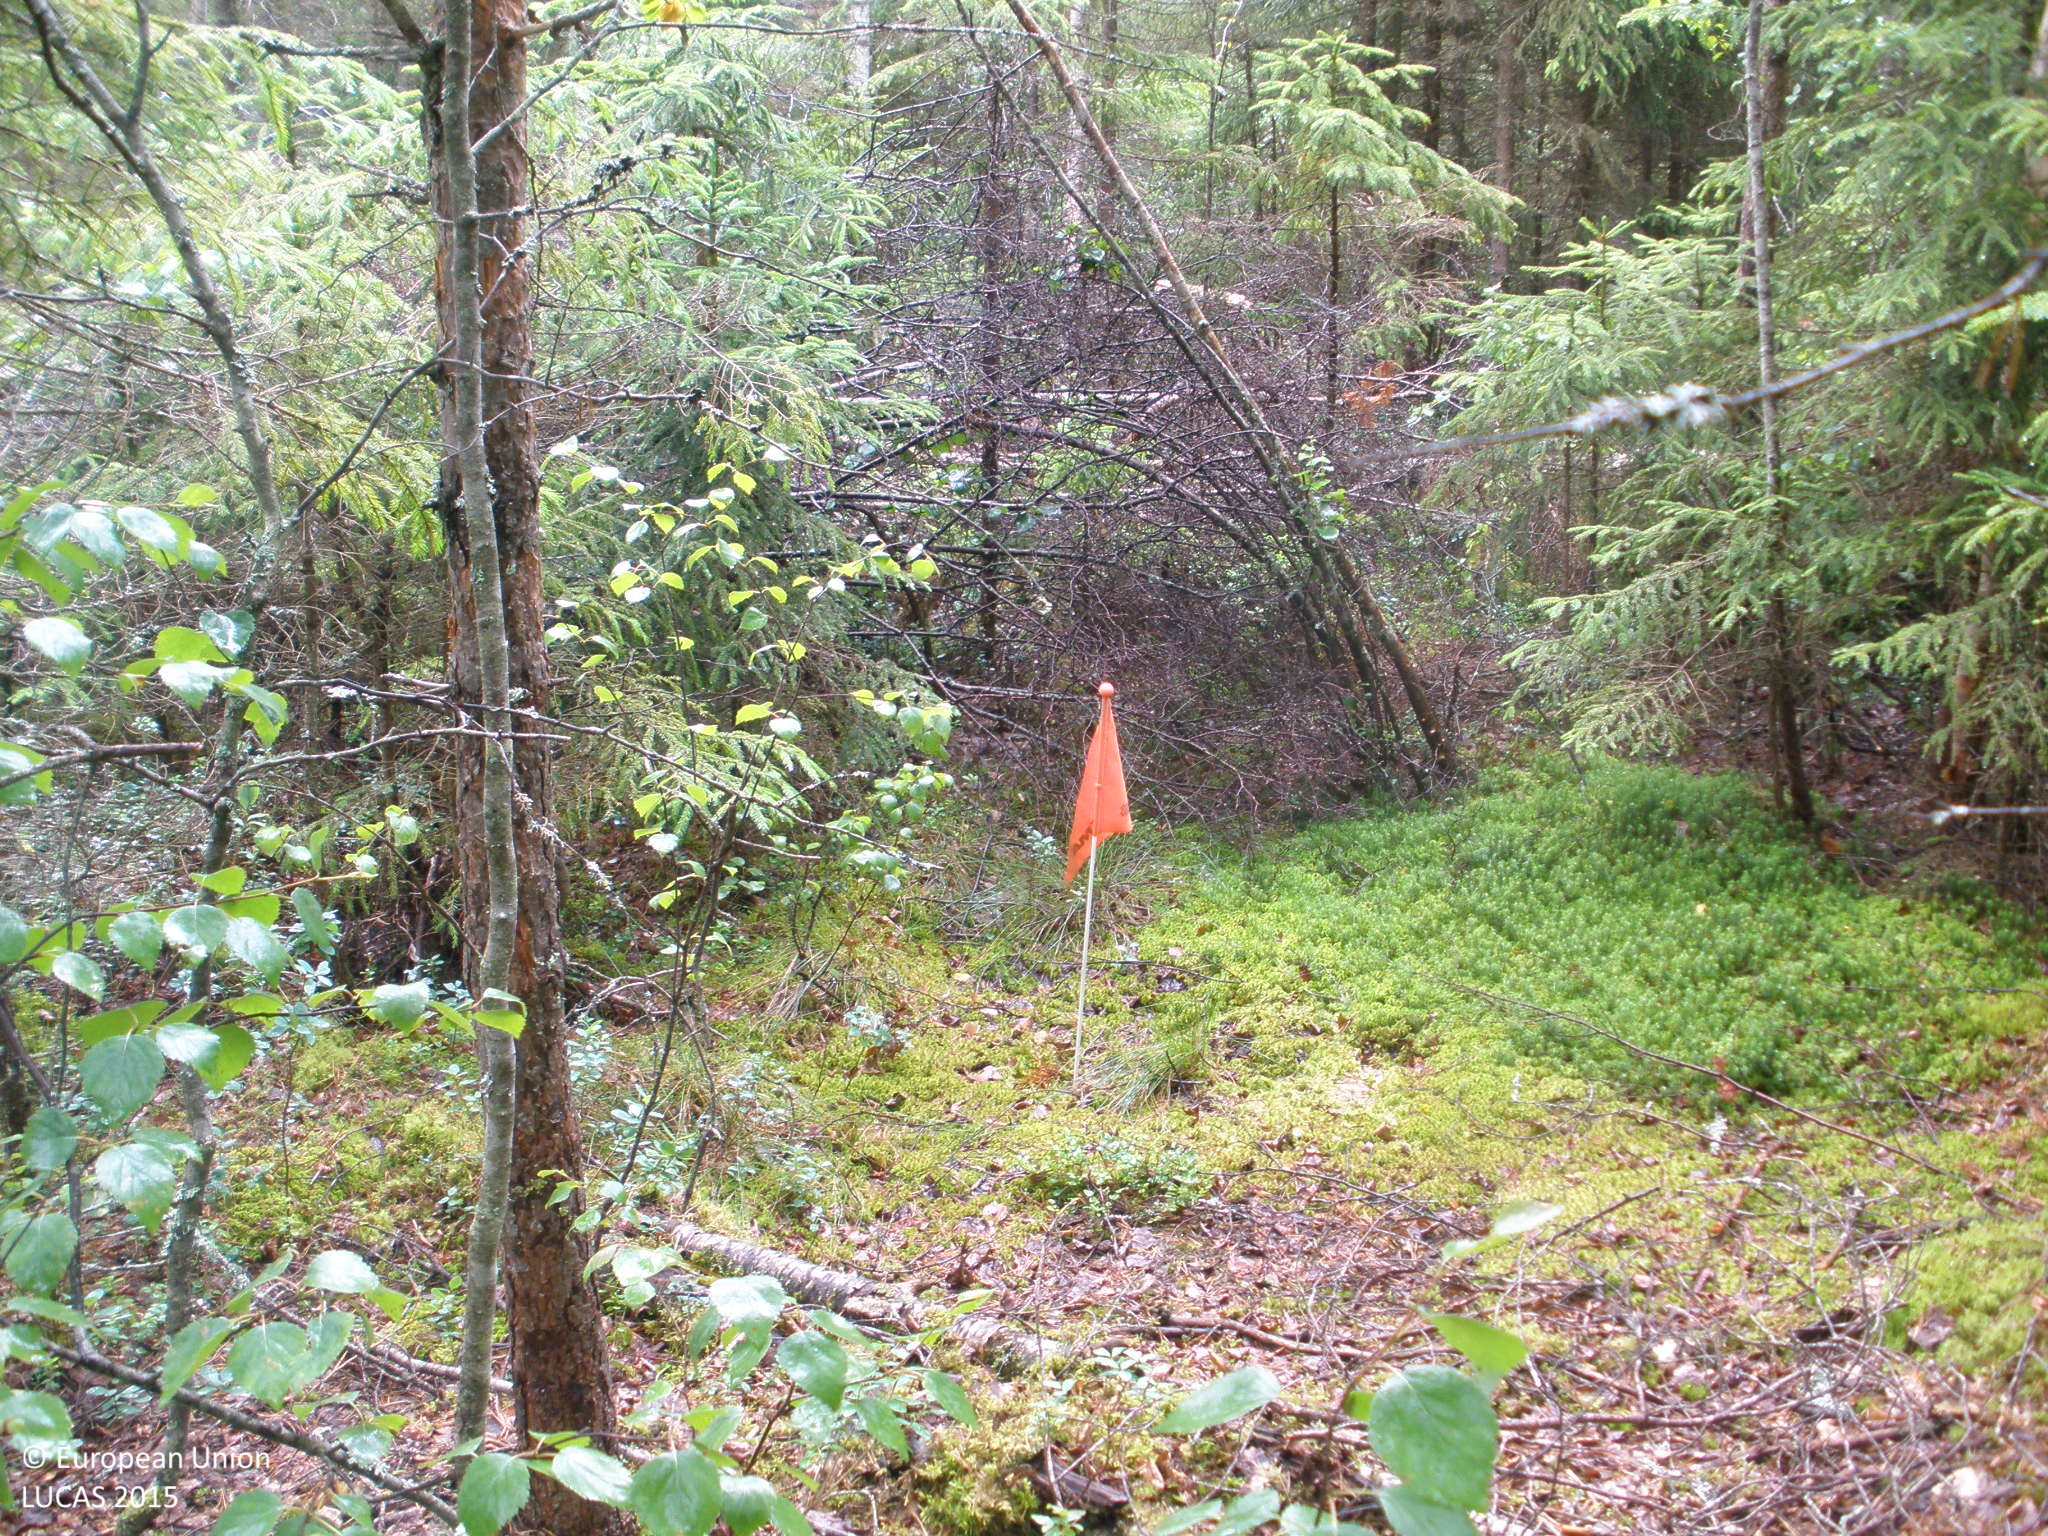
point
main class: Woodland
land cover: Pine dominated mixed woodland
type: boreal forest
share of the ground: > 75 %
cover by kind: coniferous forest trees 60 %, broadleaved forest trees 25 %, lichens and mosses 10 %, shrubs 5 %
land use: Forestry
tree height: > 5 m
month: July
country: FI
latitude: 61.0290
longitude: 24.9744
